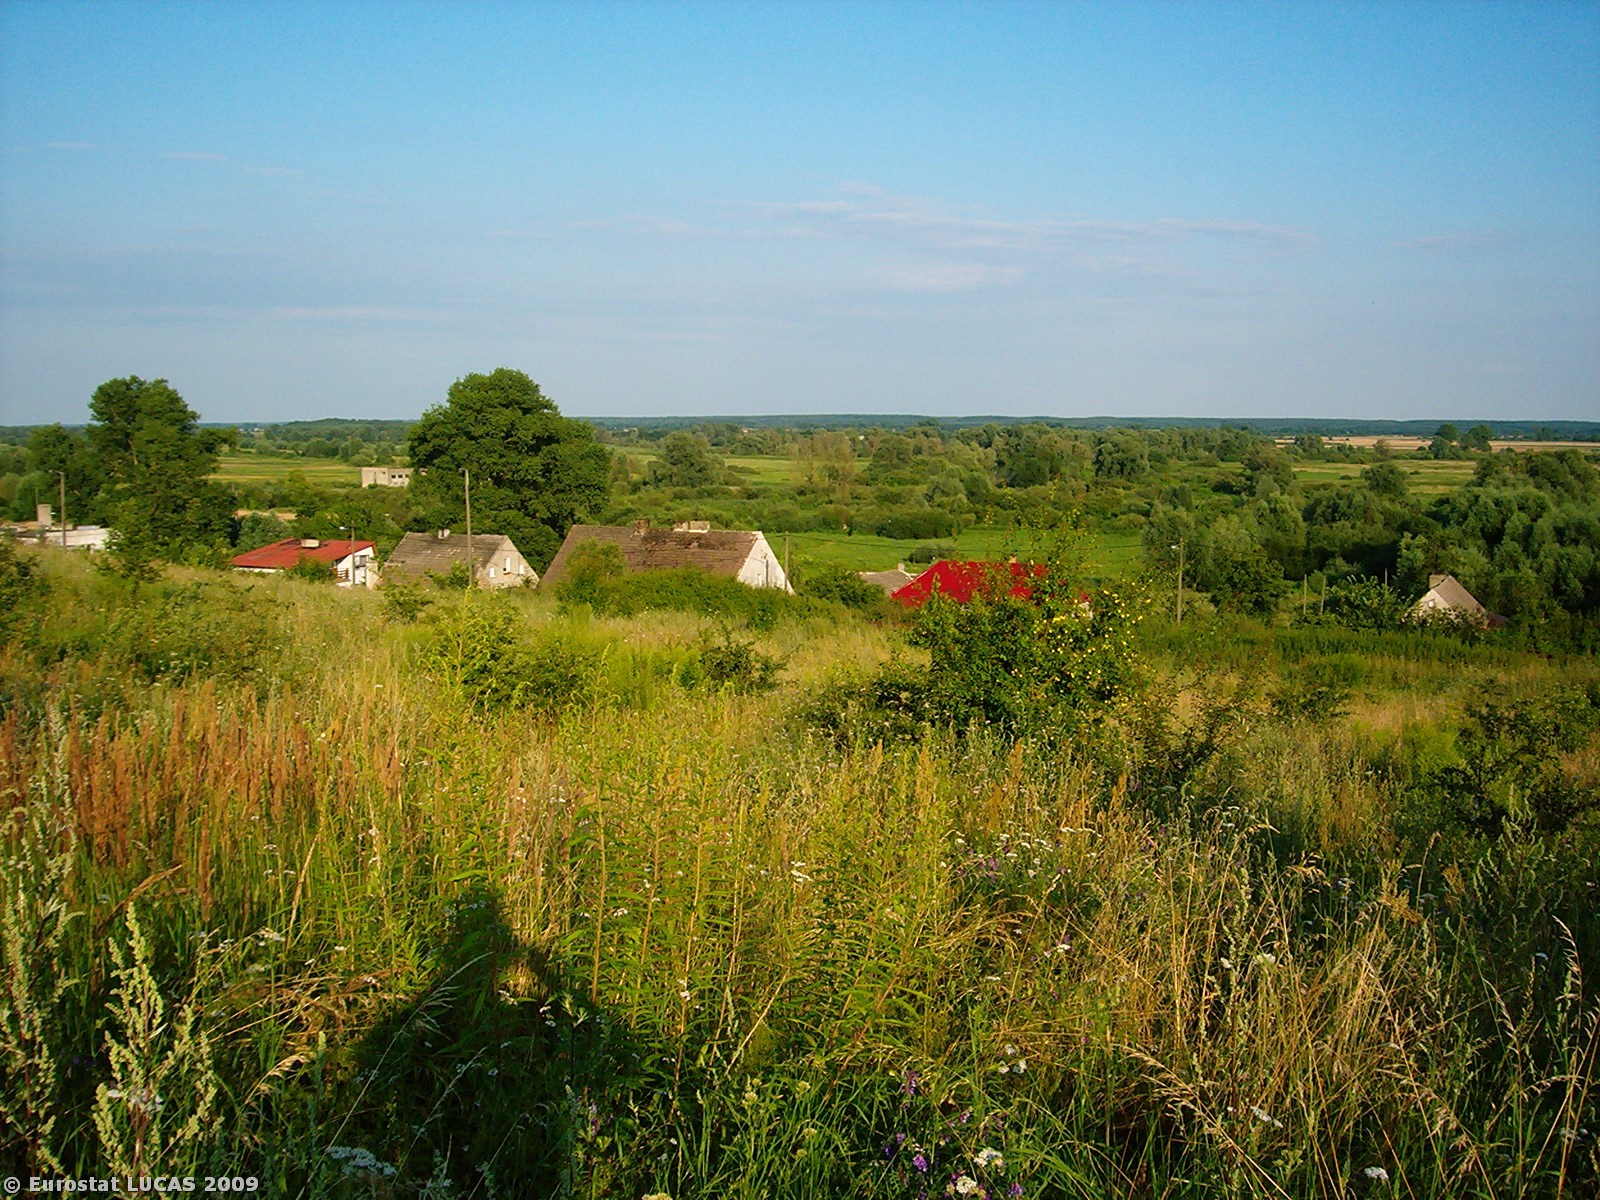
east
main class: Grassland
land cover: Grassland with sparse tree/shrub cover
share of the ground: > 75 %
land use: Unused
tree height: < 5 m
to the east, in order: Grassland with sparse tree/shrub cover; Railways; Abandoned hedges; Grassland without tree/shrub cover; Artificial constructions in urban areas
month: July
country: PL
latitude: 52.7406
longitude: 15.4099
